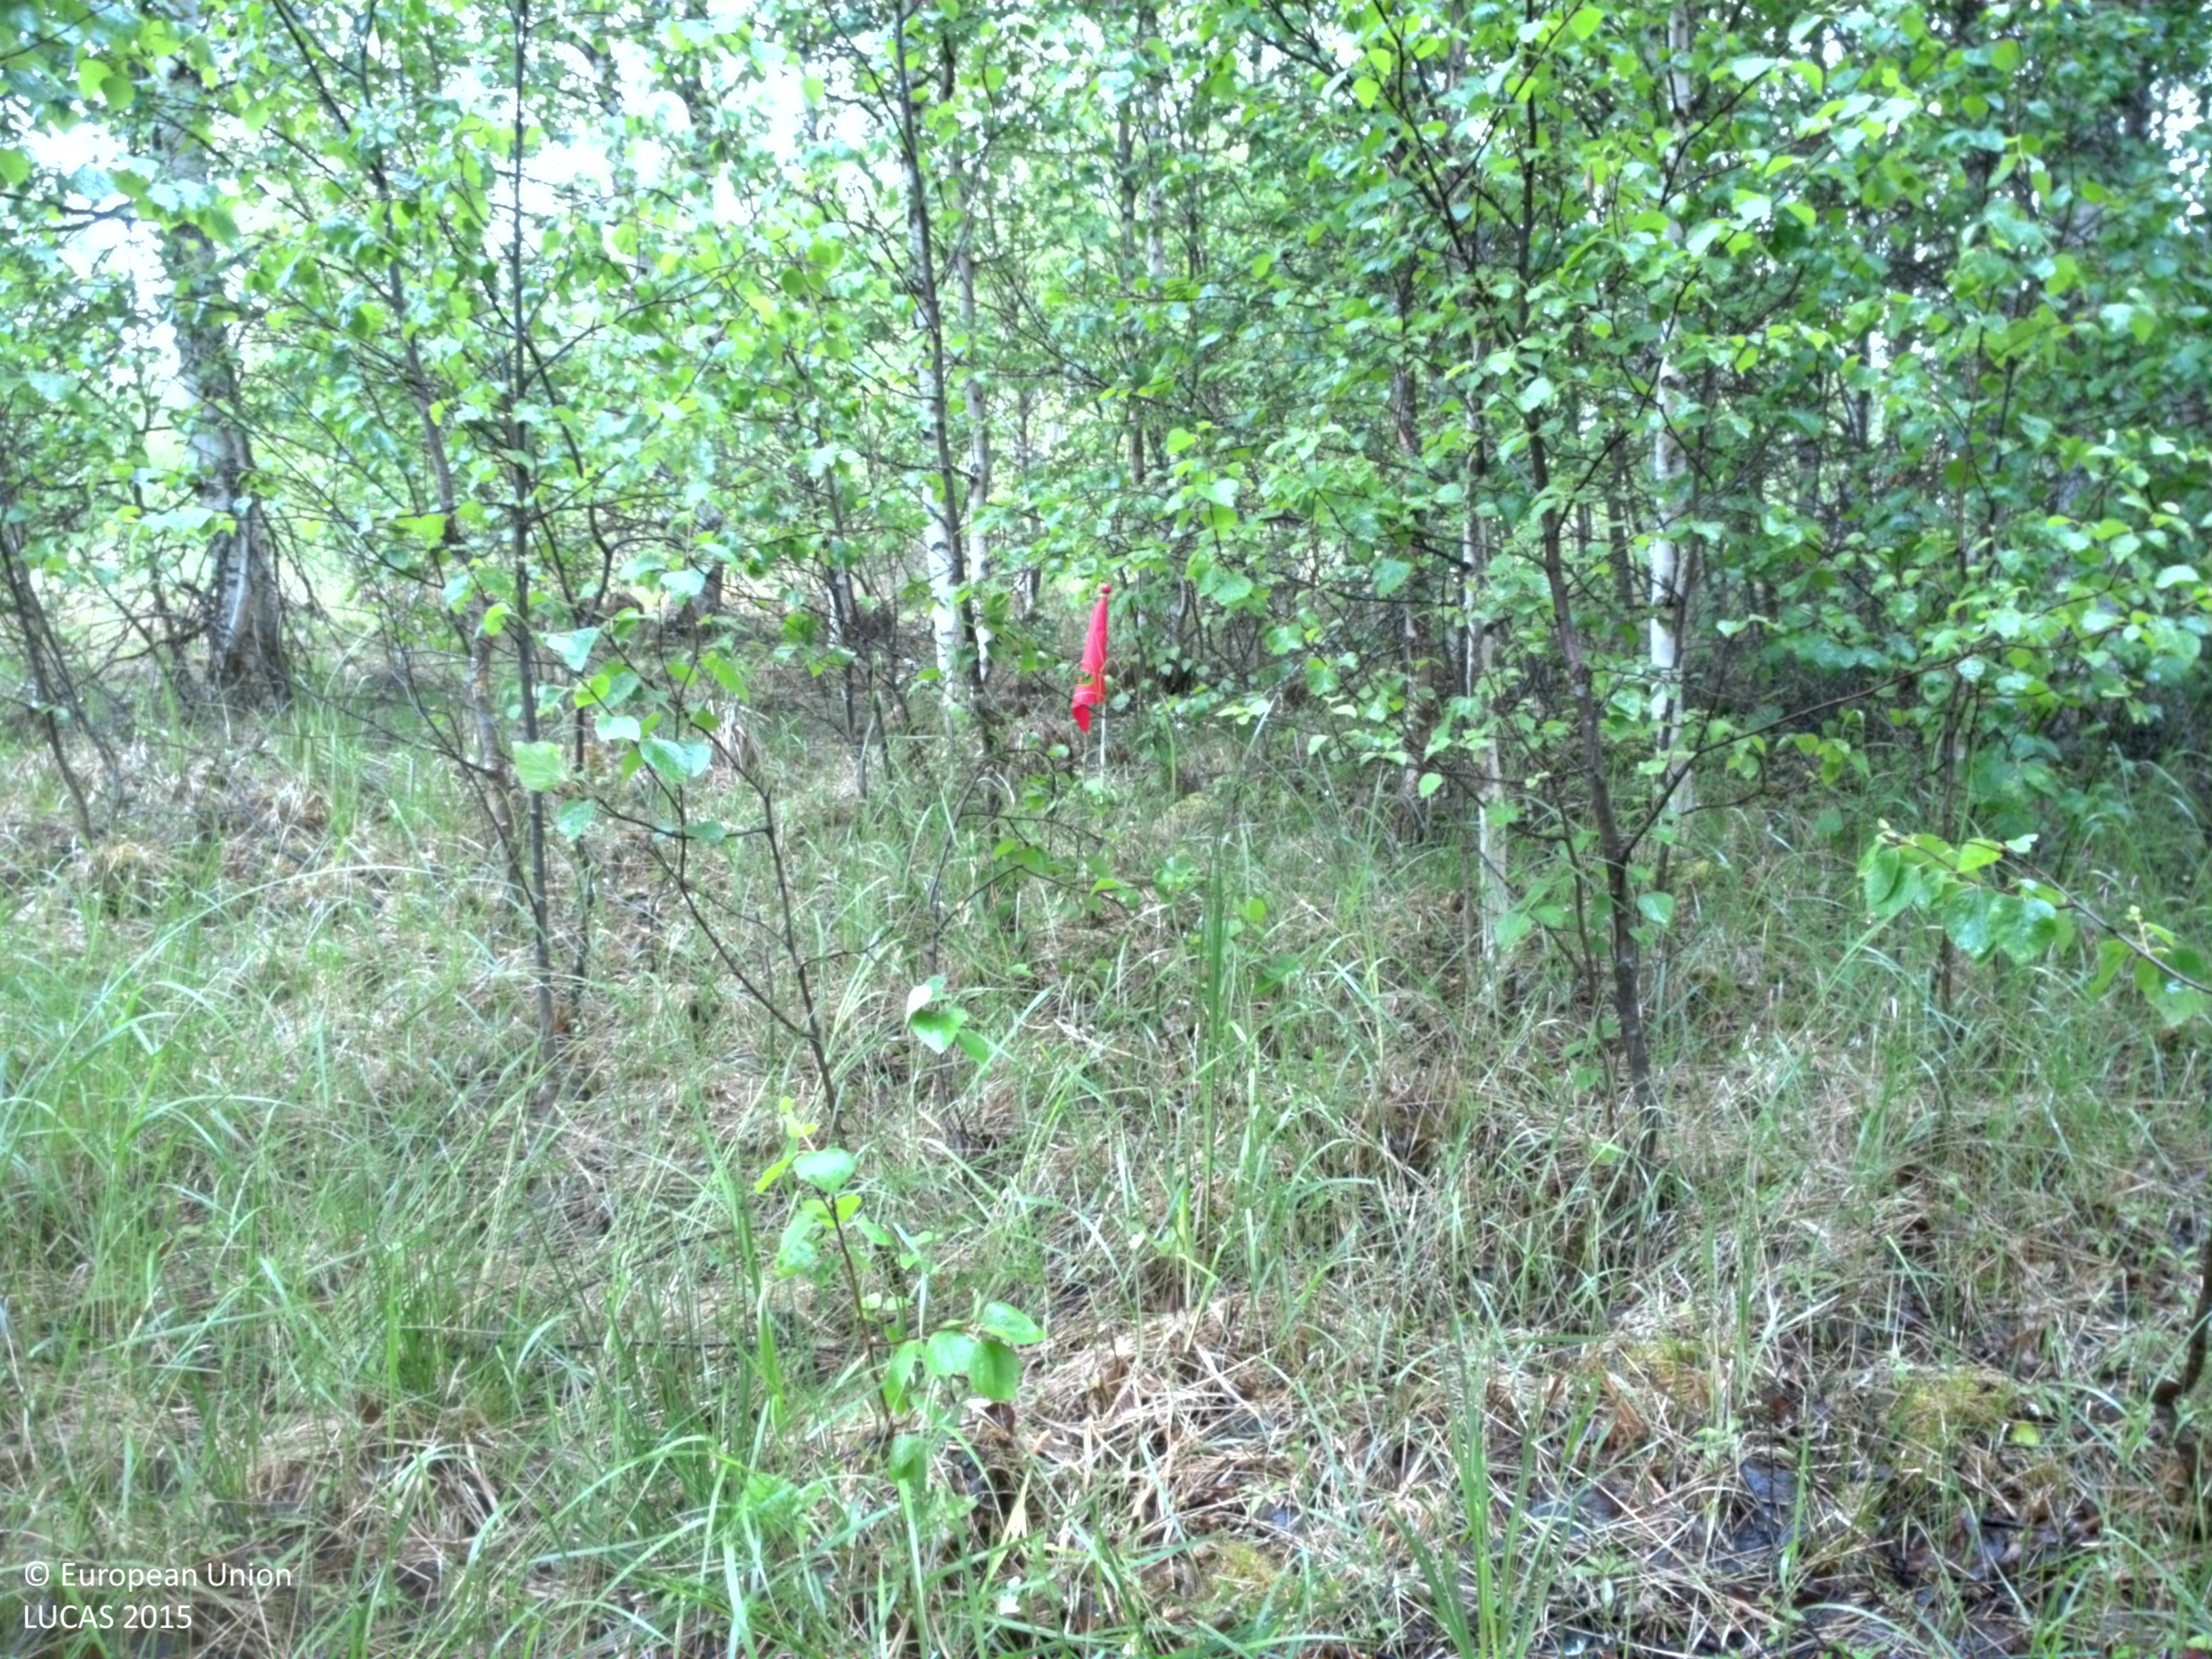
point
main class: Woodland
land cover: Broadleaved woodland
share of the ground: > 75 %
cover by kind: broadleaved forest trees 85 %, shrubs 5 %, herbaceous plants 5 %, lichens and mosses 5 %
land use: Forestry
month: June
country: SE
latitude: 66.3761
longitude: 22.7906
